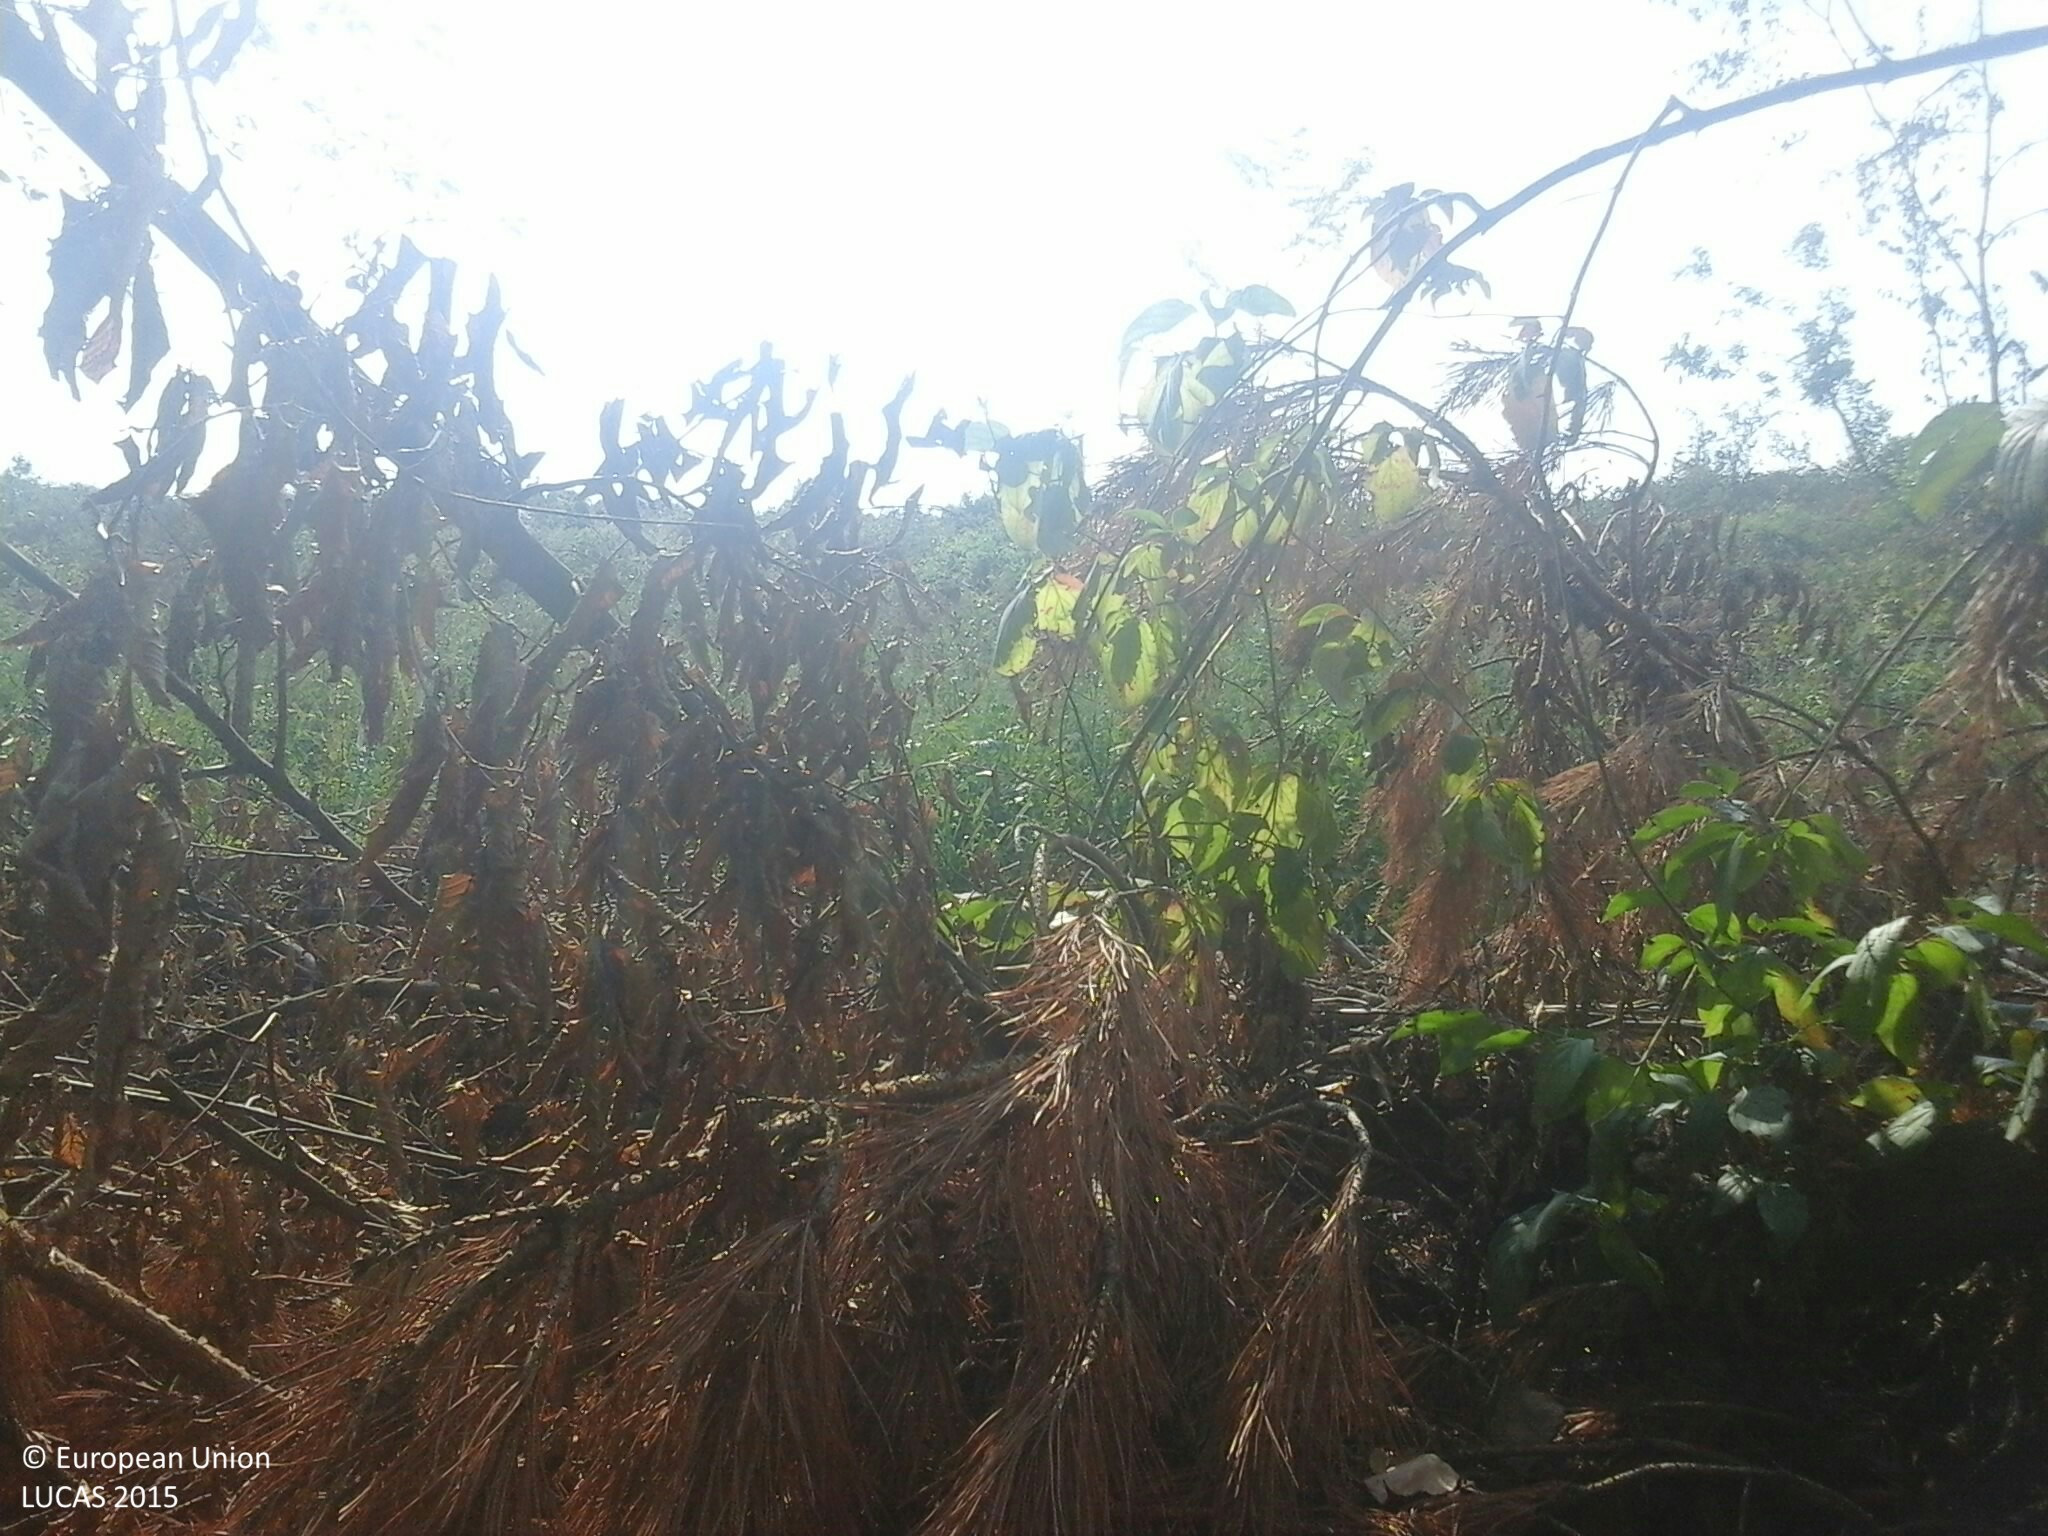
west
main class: Woodland
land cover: Broadleaved woodland
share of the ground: 50 - 75 %
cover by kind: broadleaved forest trees 50 %, shrubs 50 %
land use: Forestry
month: August
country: HU
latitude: 45.9576
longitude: 18.2775
